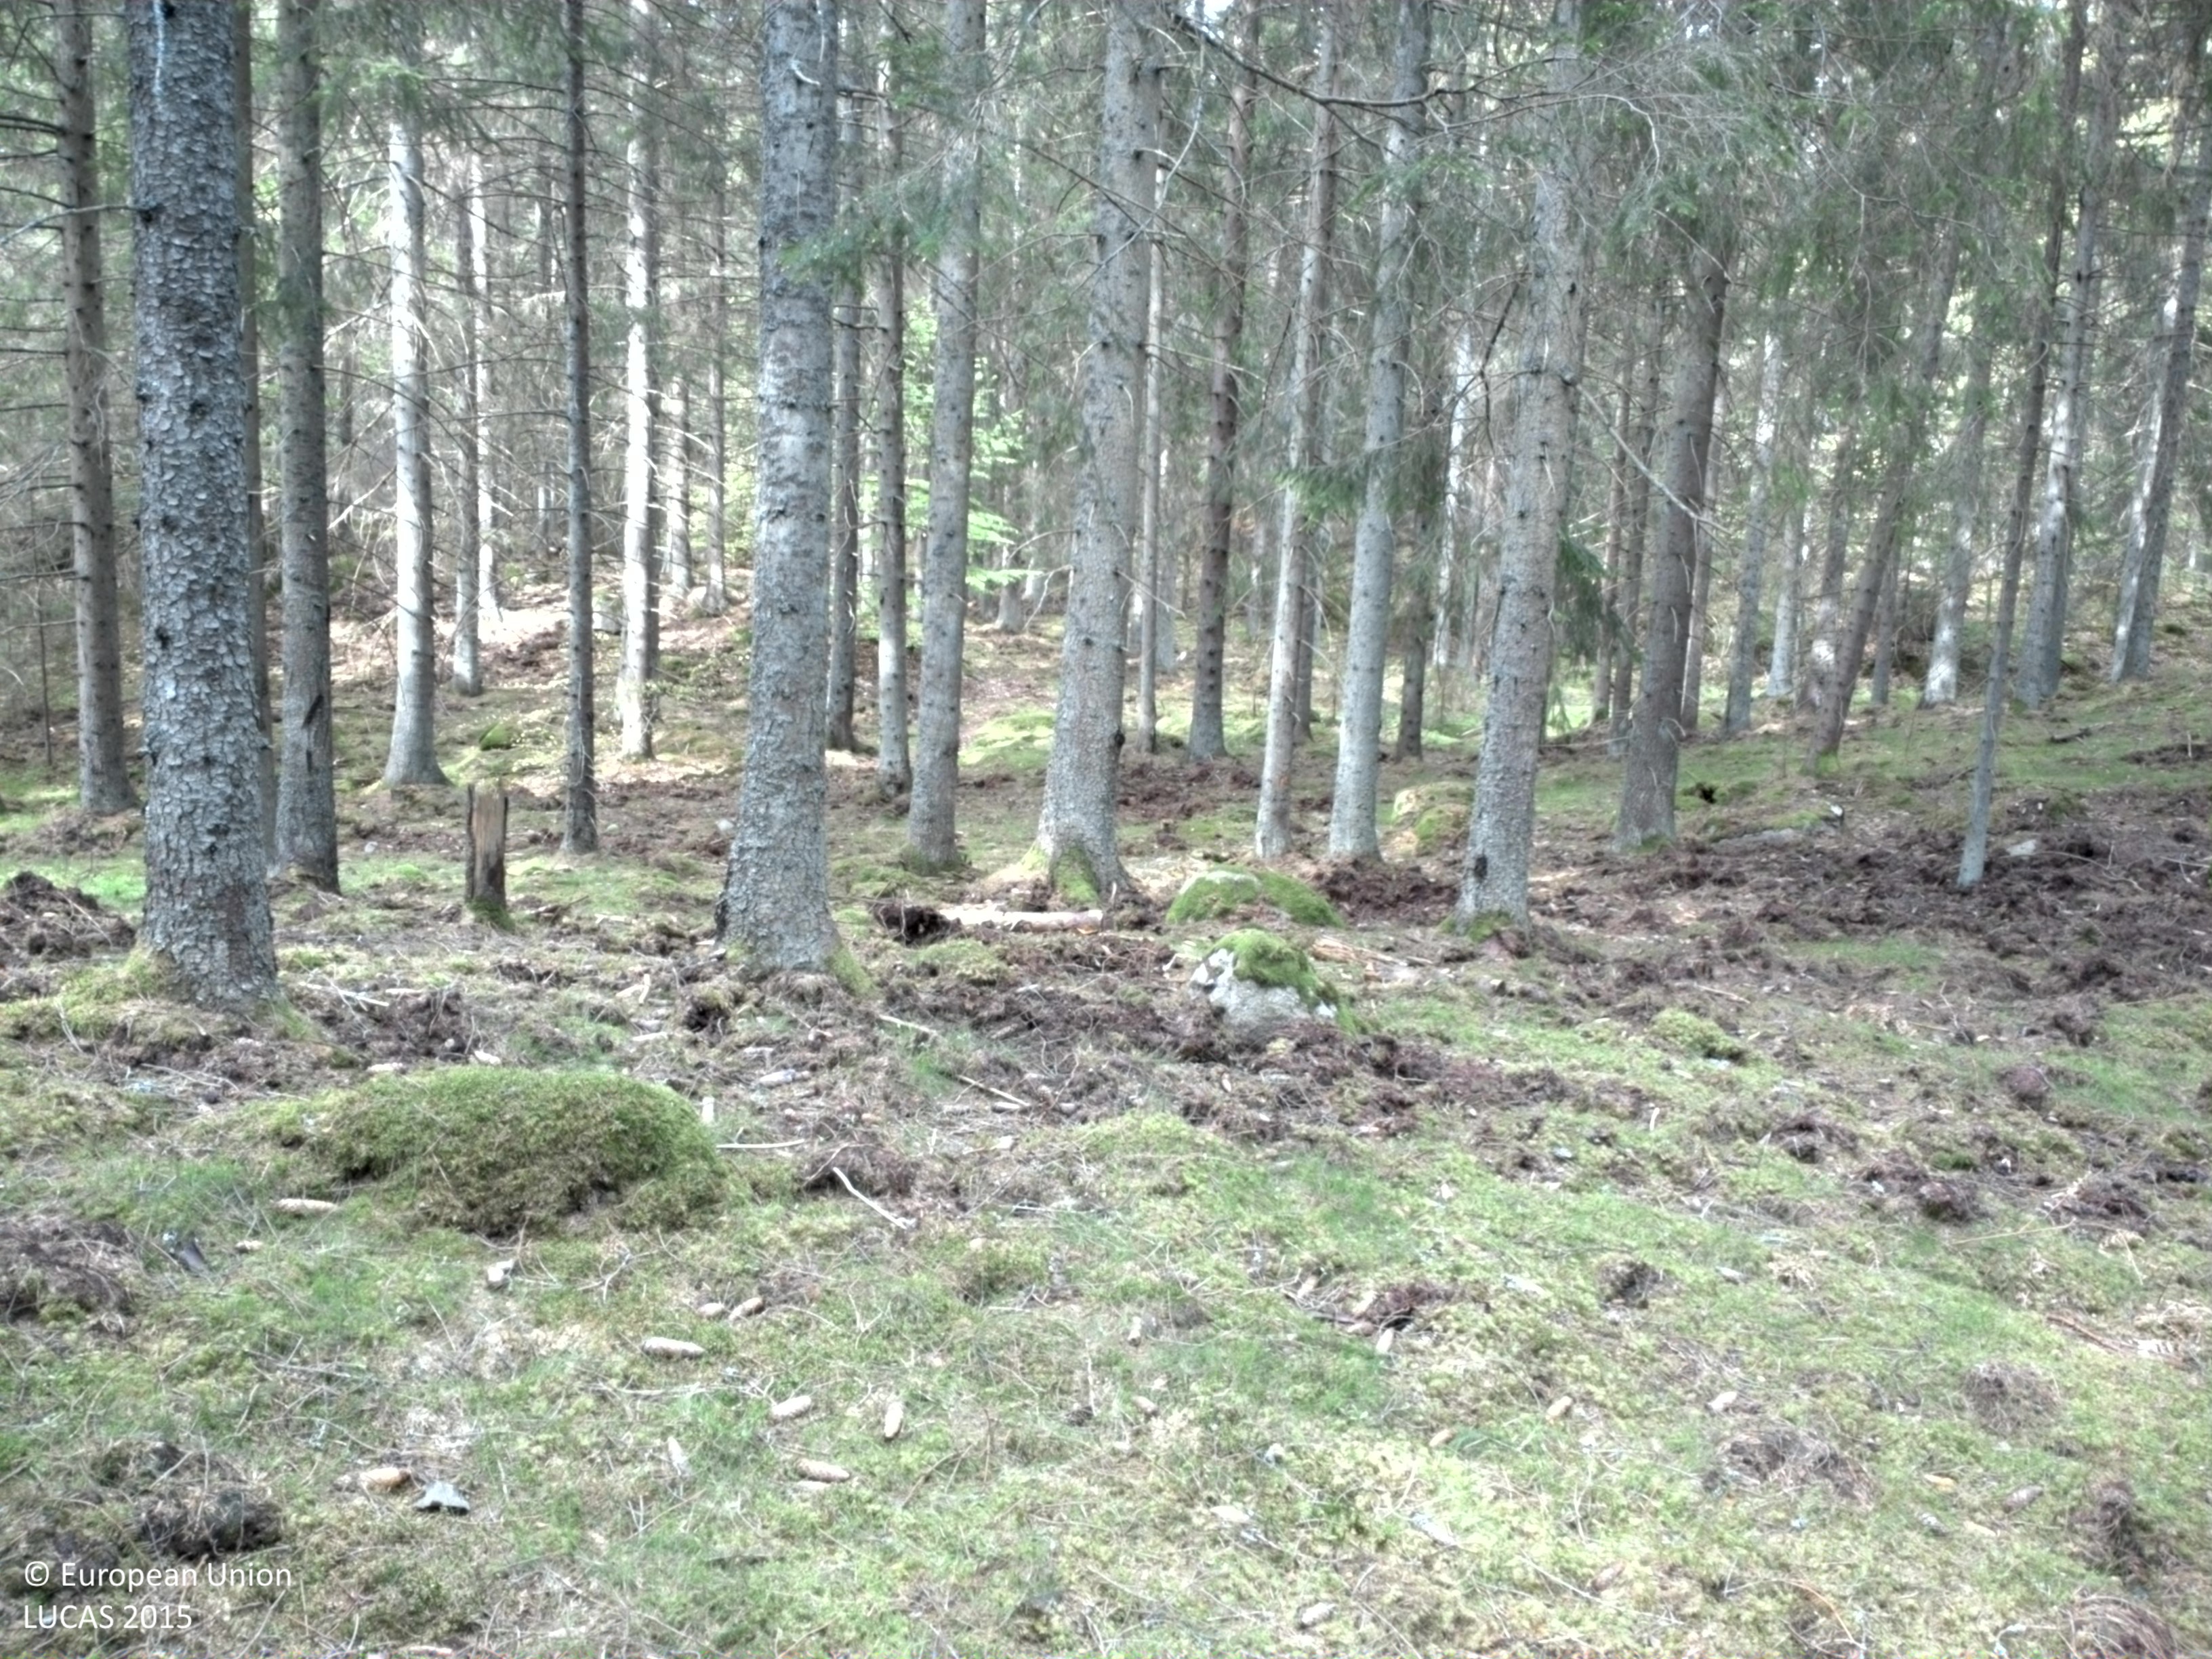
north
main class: Woodland
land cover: Spruce dominated coniferous woodland
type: boreal forest
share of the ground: > 75 %
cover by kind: coniferous forest trees 90 %, lichens and mosses 10 %
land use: Forestry
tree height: > 5 m
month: May
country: SE
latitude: 56.4343
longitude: 15.8219
